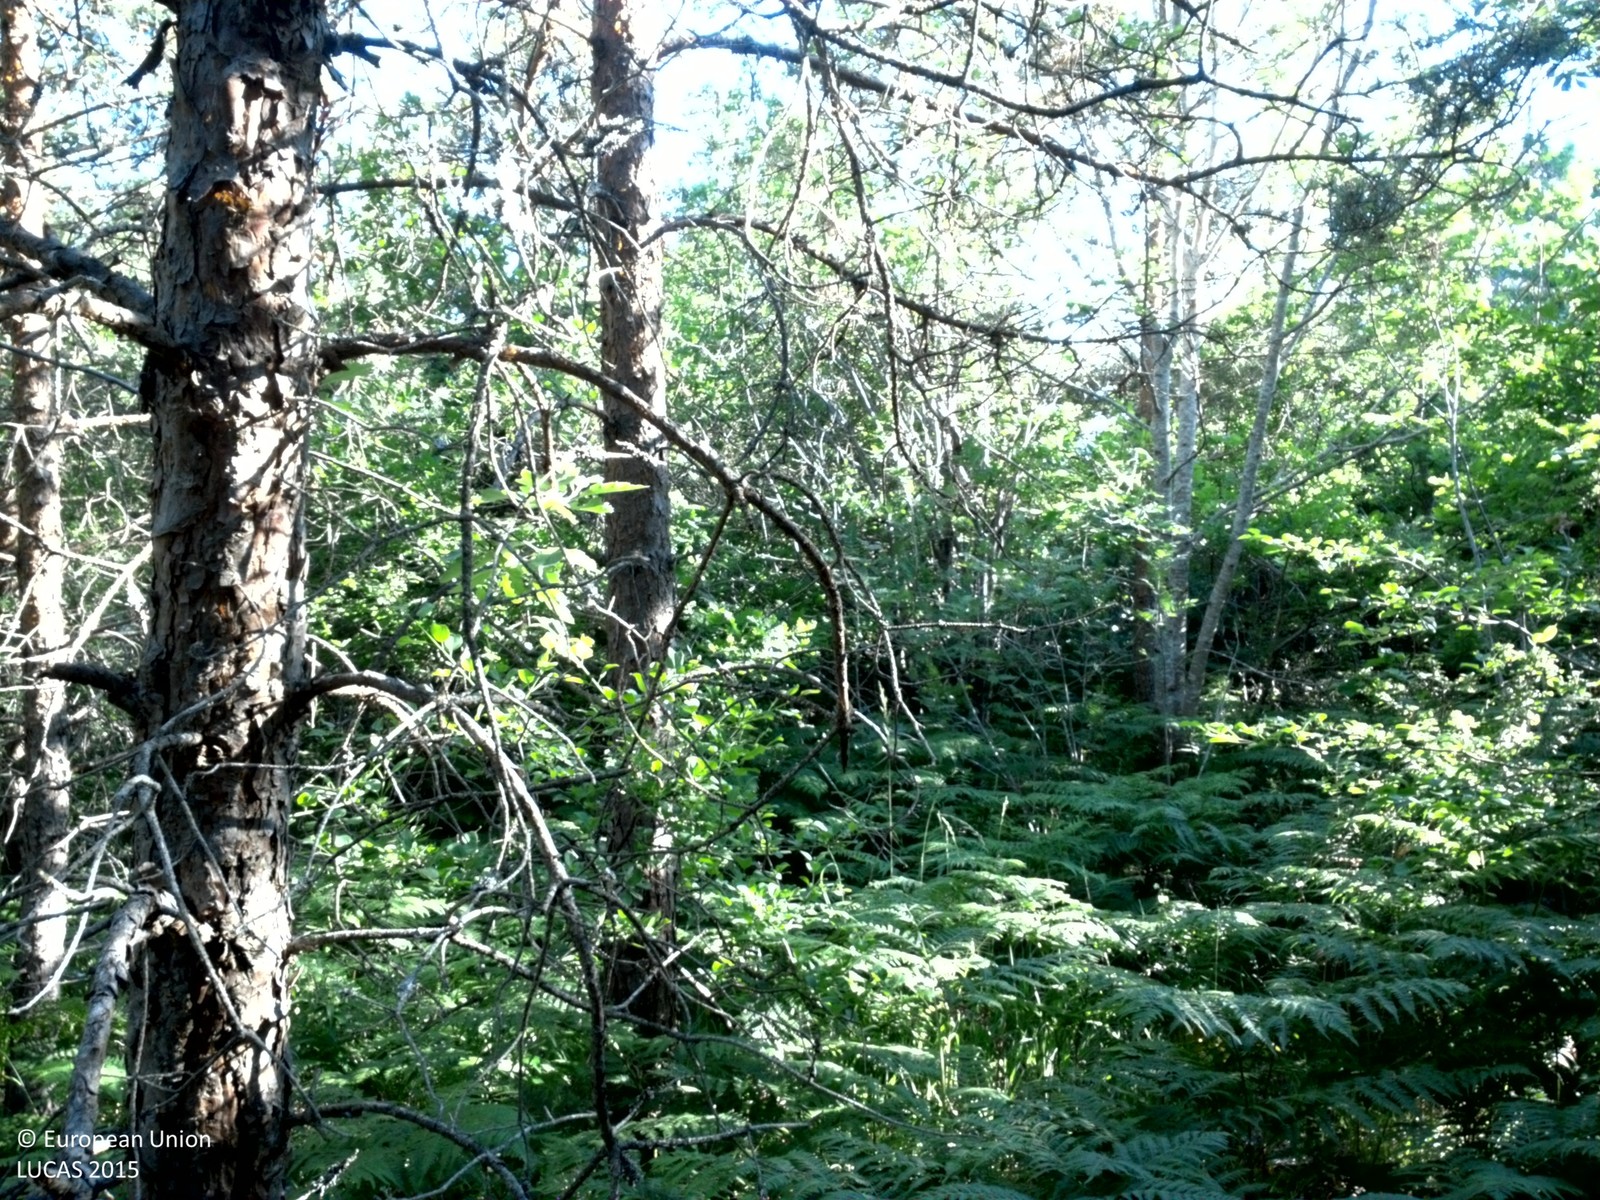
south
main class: Woodland
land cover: Pine dominated mixed woodland
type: hemiboreal forest and nemoral coniferous forest and mixed broadleaved-coniferous forest
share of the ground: > 75 %
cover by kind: coniferous forest trees 45 %, broadleaved forest trees 30 %, shrubs 15 %, herbaceous plants 10 %
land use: Semi-natural and natural areas not in use
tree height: > 5 m
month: July
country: SE
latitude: 57.7653
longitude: 18.8348
